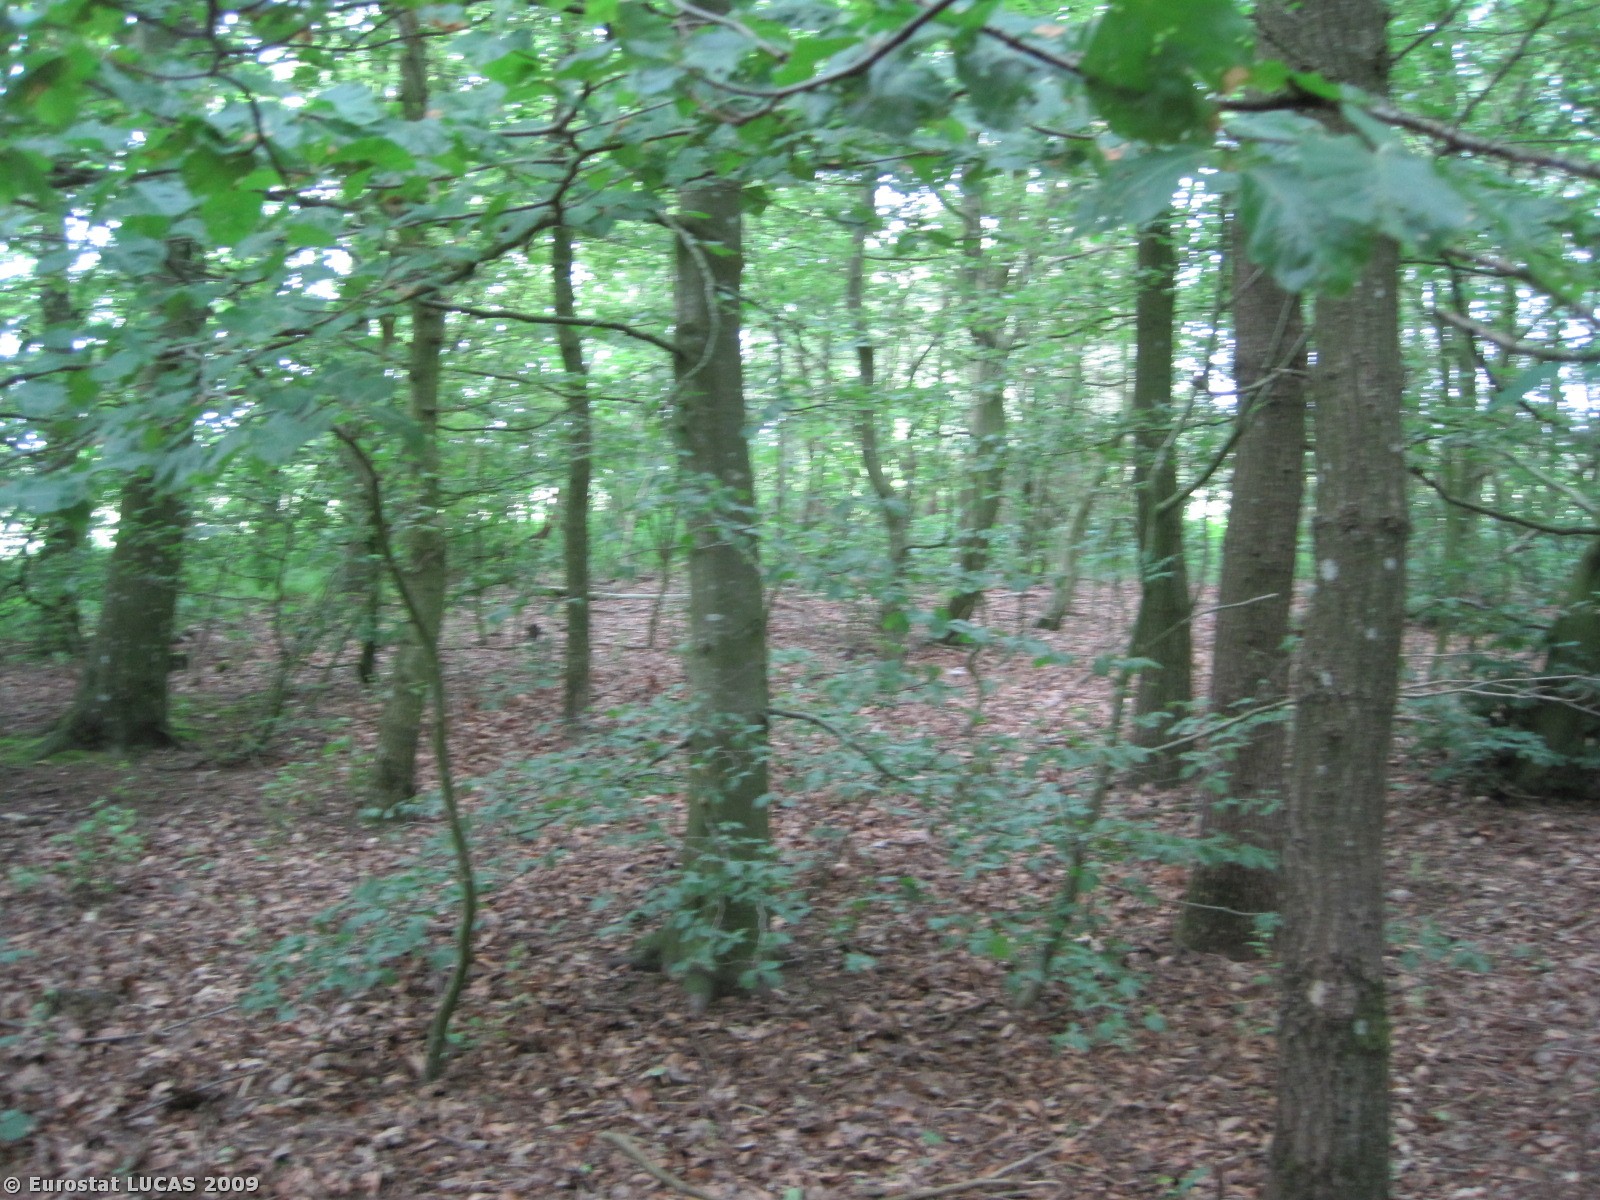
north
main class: Woodland
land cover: Broadleaved woodland
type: plantations and self-sown exotic forest
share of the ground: > 75 %
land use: Unused
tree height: > 5 m
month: June
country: DK
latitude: 57.2124
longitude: 10.0496
